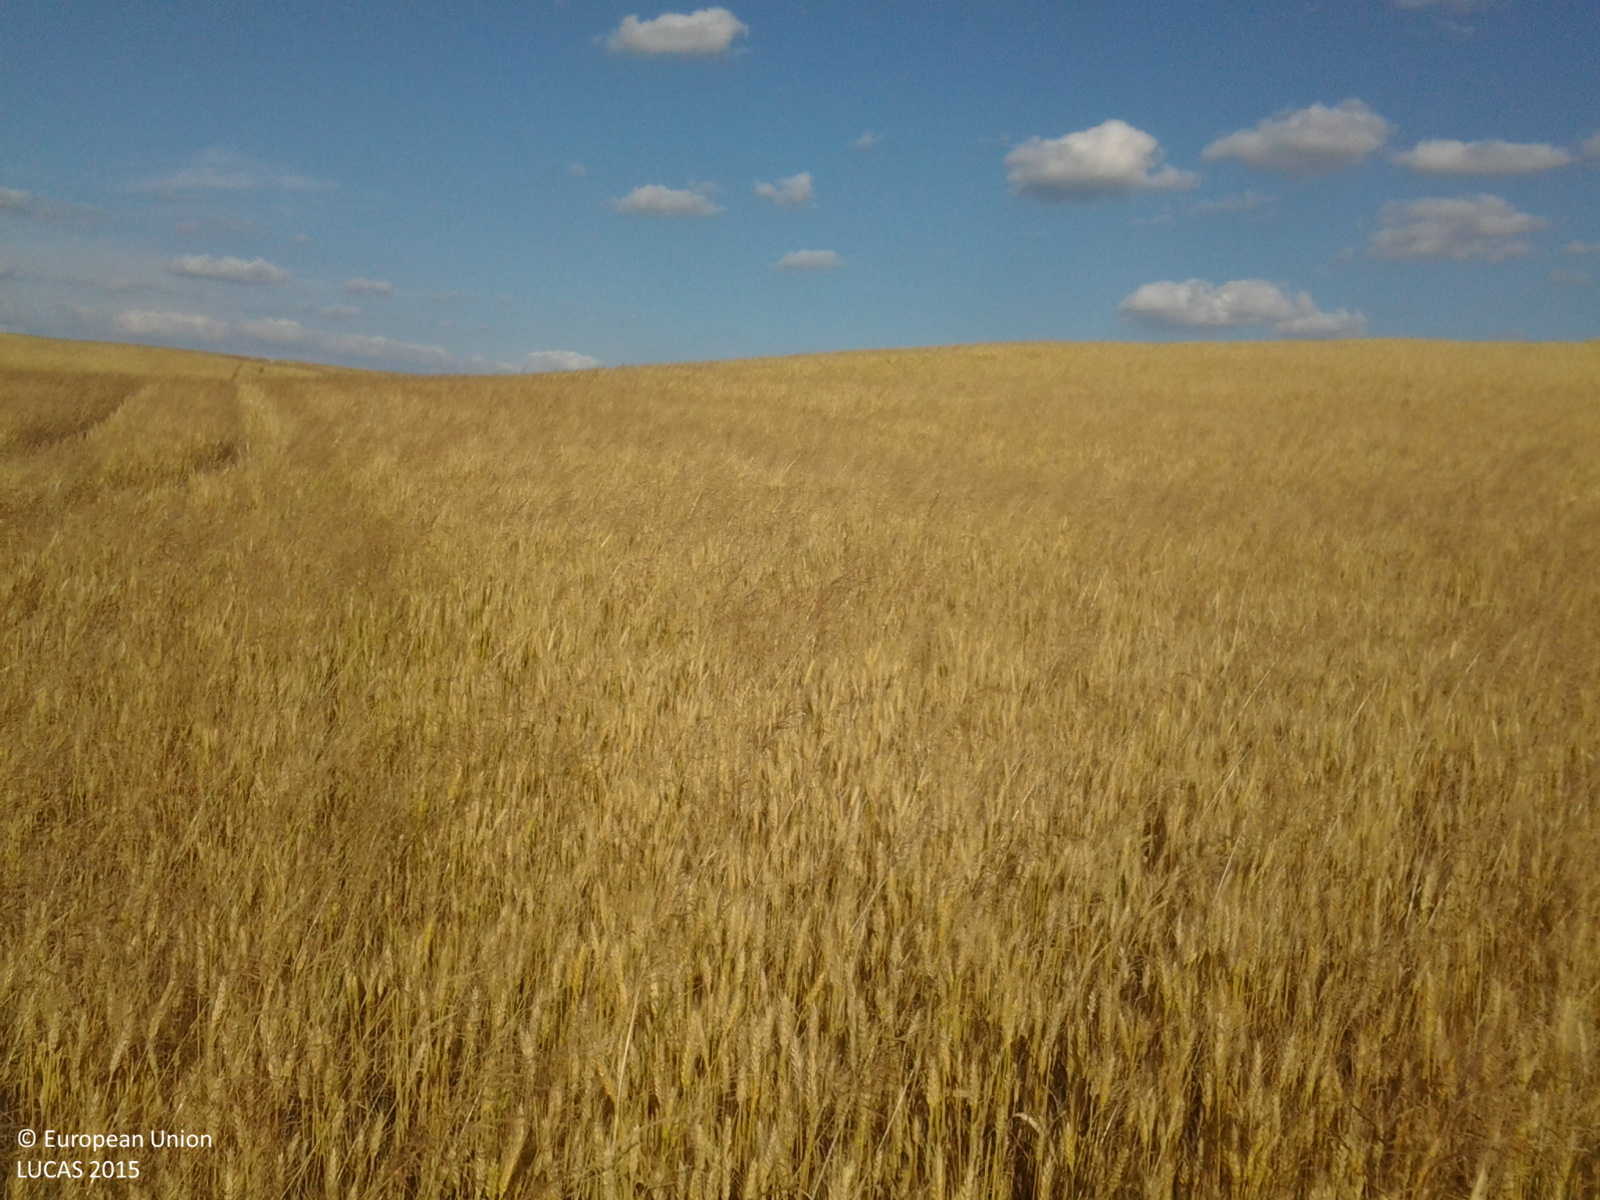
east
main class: Cropland
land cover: Common wheat
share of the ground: > 75 %
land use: Agriculture (excluding fallow land and kitchen gardens)
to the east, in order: Common wheat
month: June
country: HU
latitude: 47.2092
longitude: 17.4931
